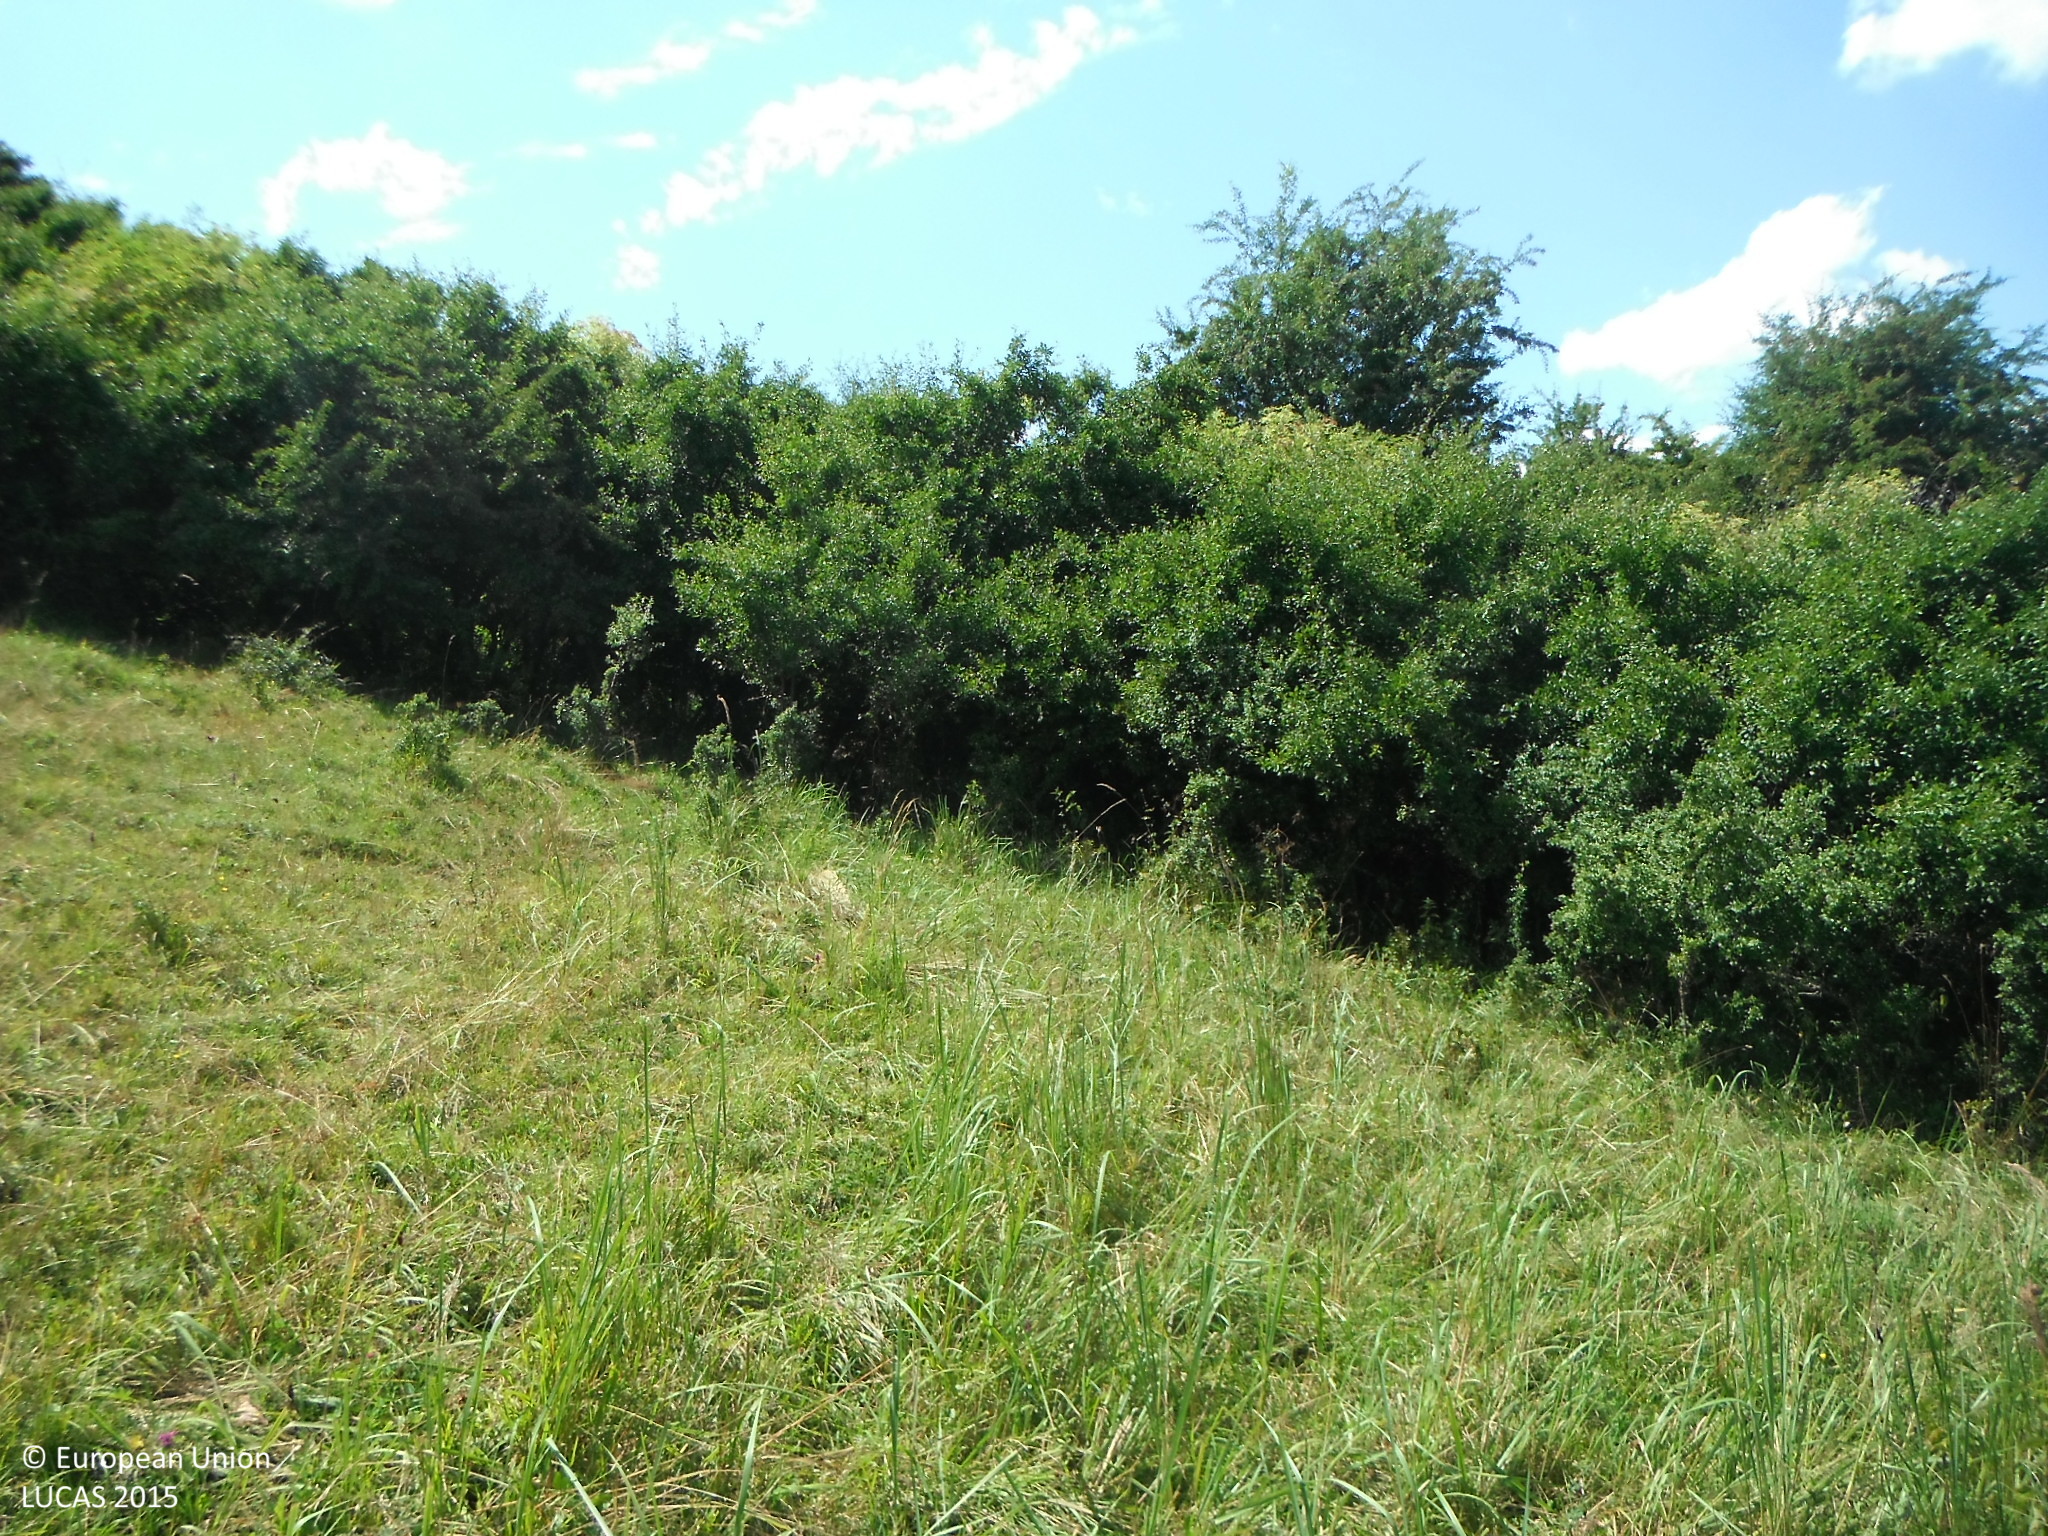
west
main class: Grassland
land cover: Grassland without tree/shrub cover
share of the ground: > 75 %
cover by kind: herbaceous plants 100 %
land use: Agriculture (excluding fallow land and kitchen gardens)
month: July
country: SK
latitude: 48.9912
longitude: 20.6843
